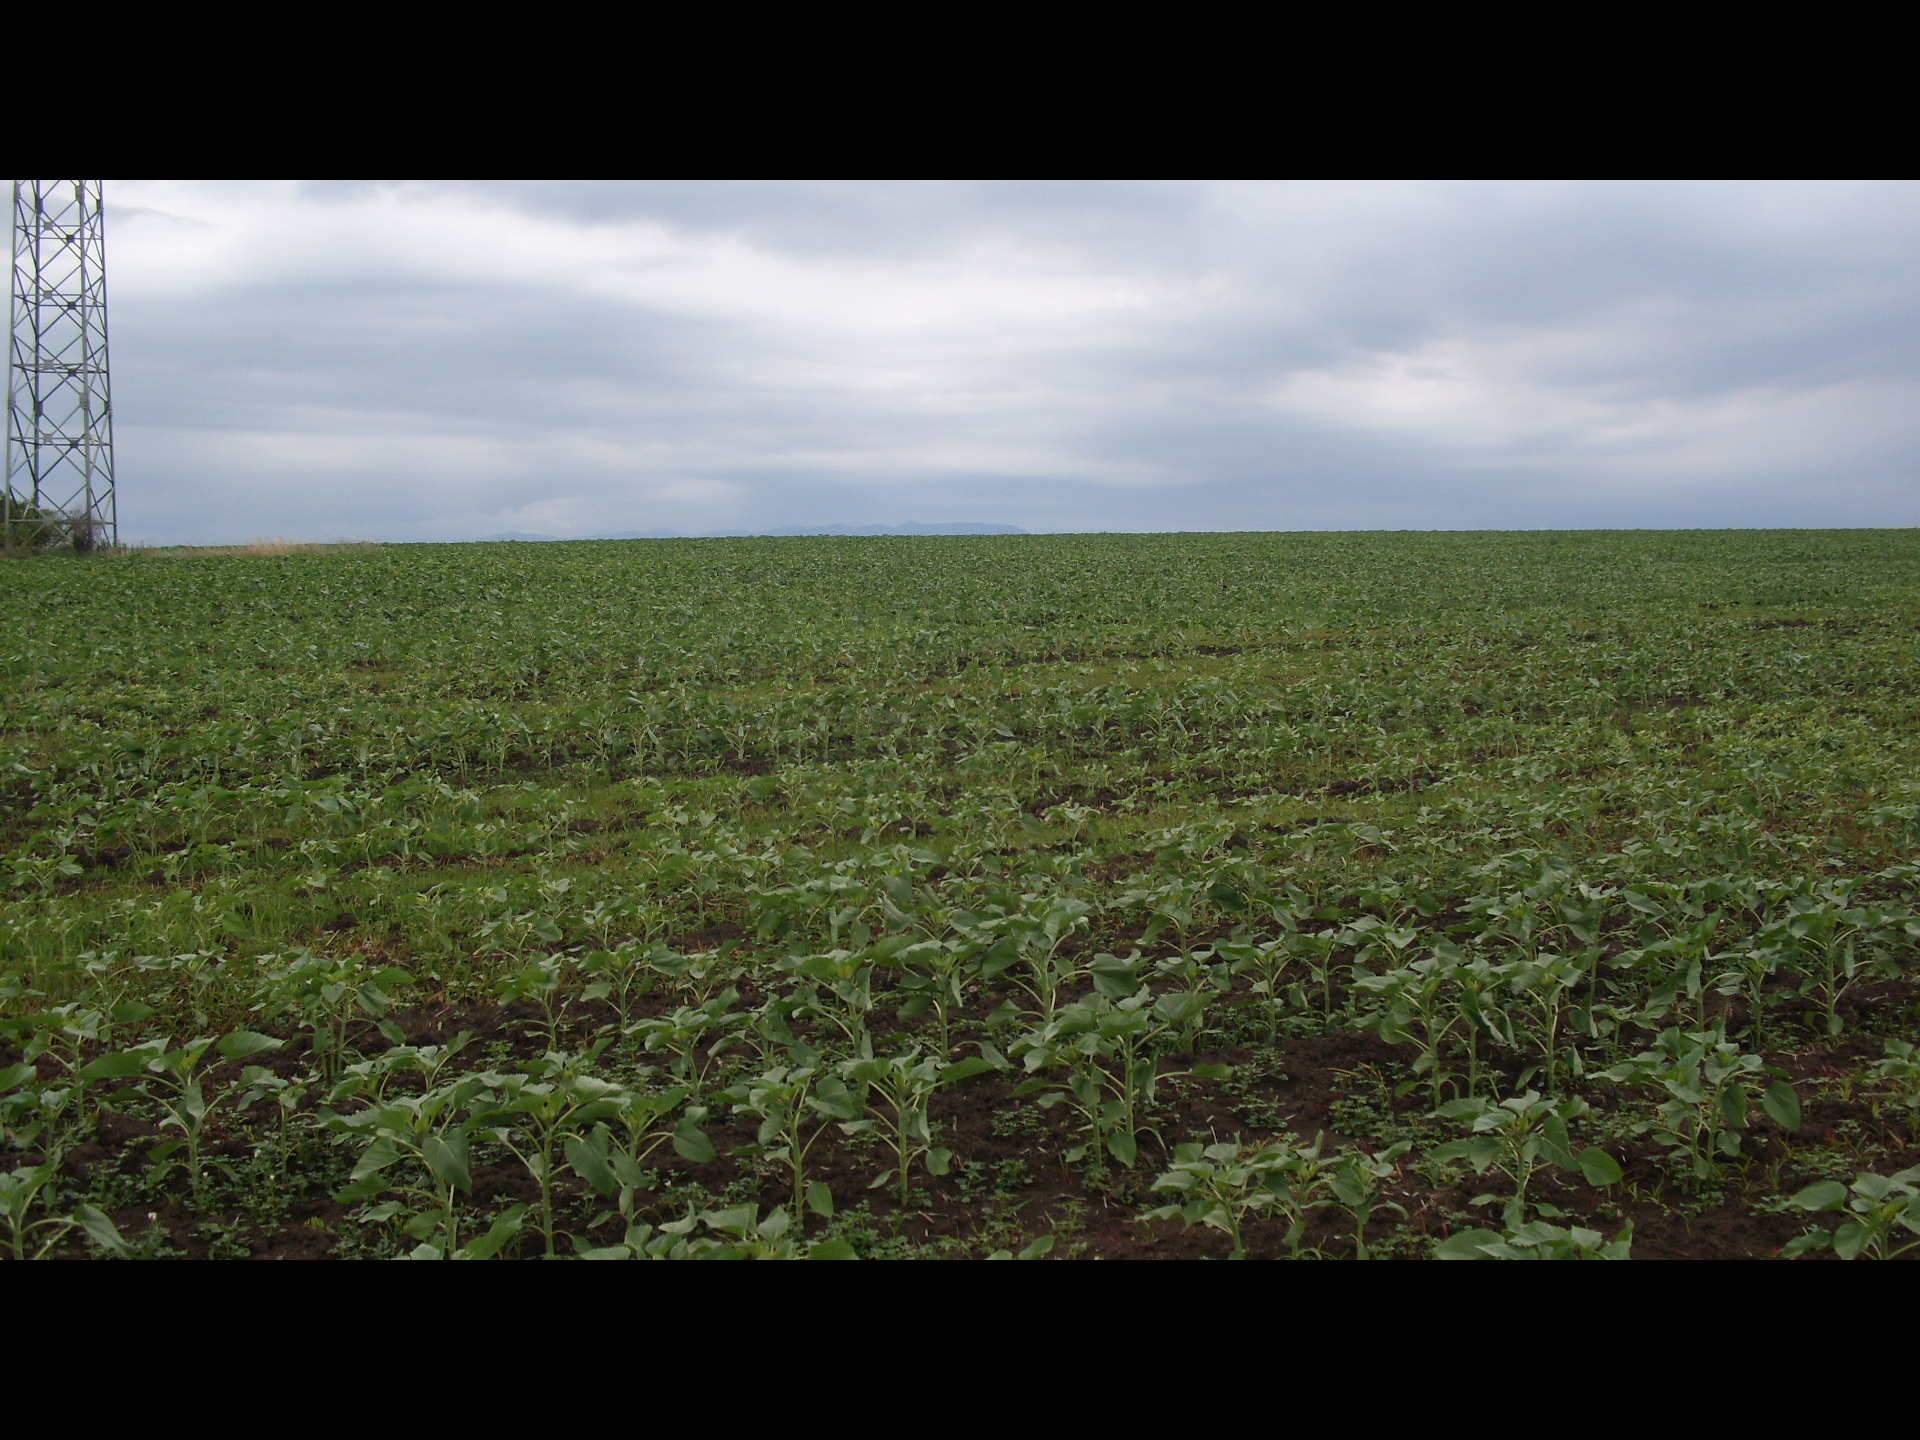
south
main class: Cropland
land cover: Sunflower
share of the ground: 25 - 50 %
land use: Agriculture (excluding fallow land and kitchen gardens)
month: June
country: BG
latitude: 43.4422
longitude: 23.5245
